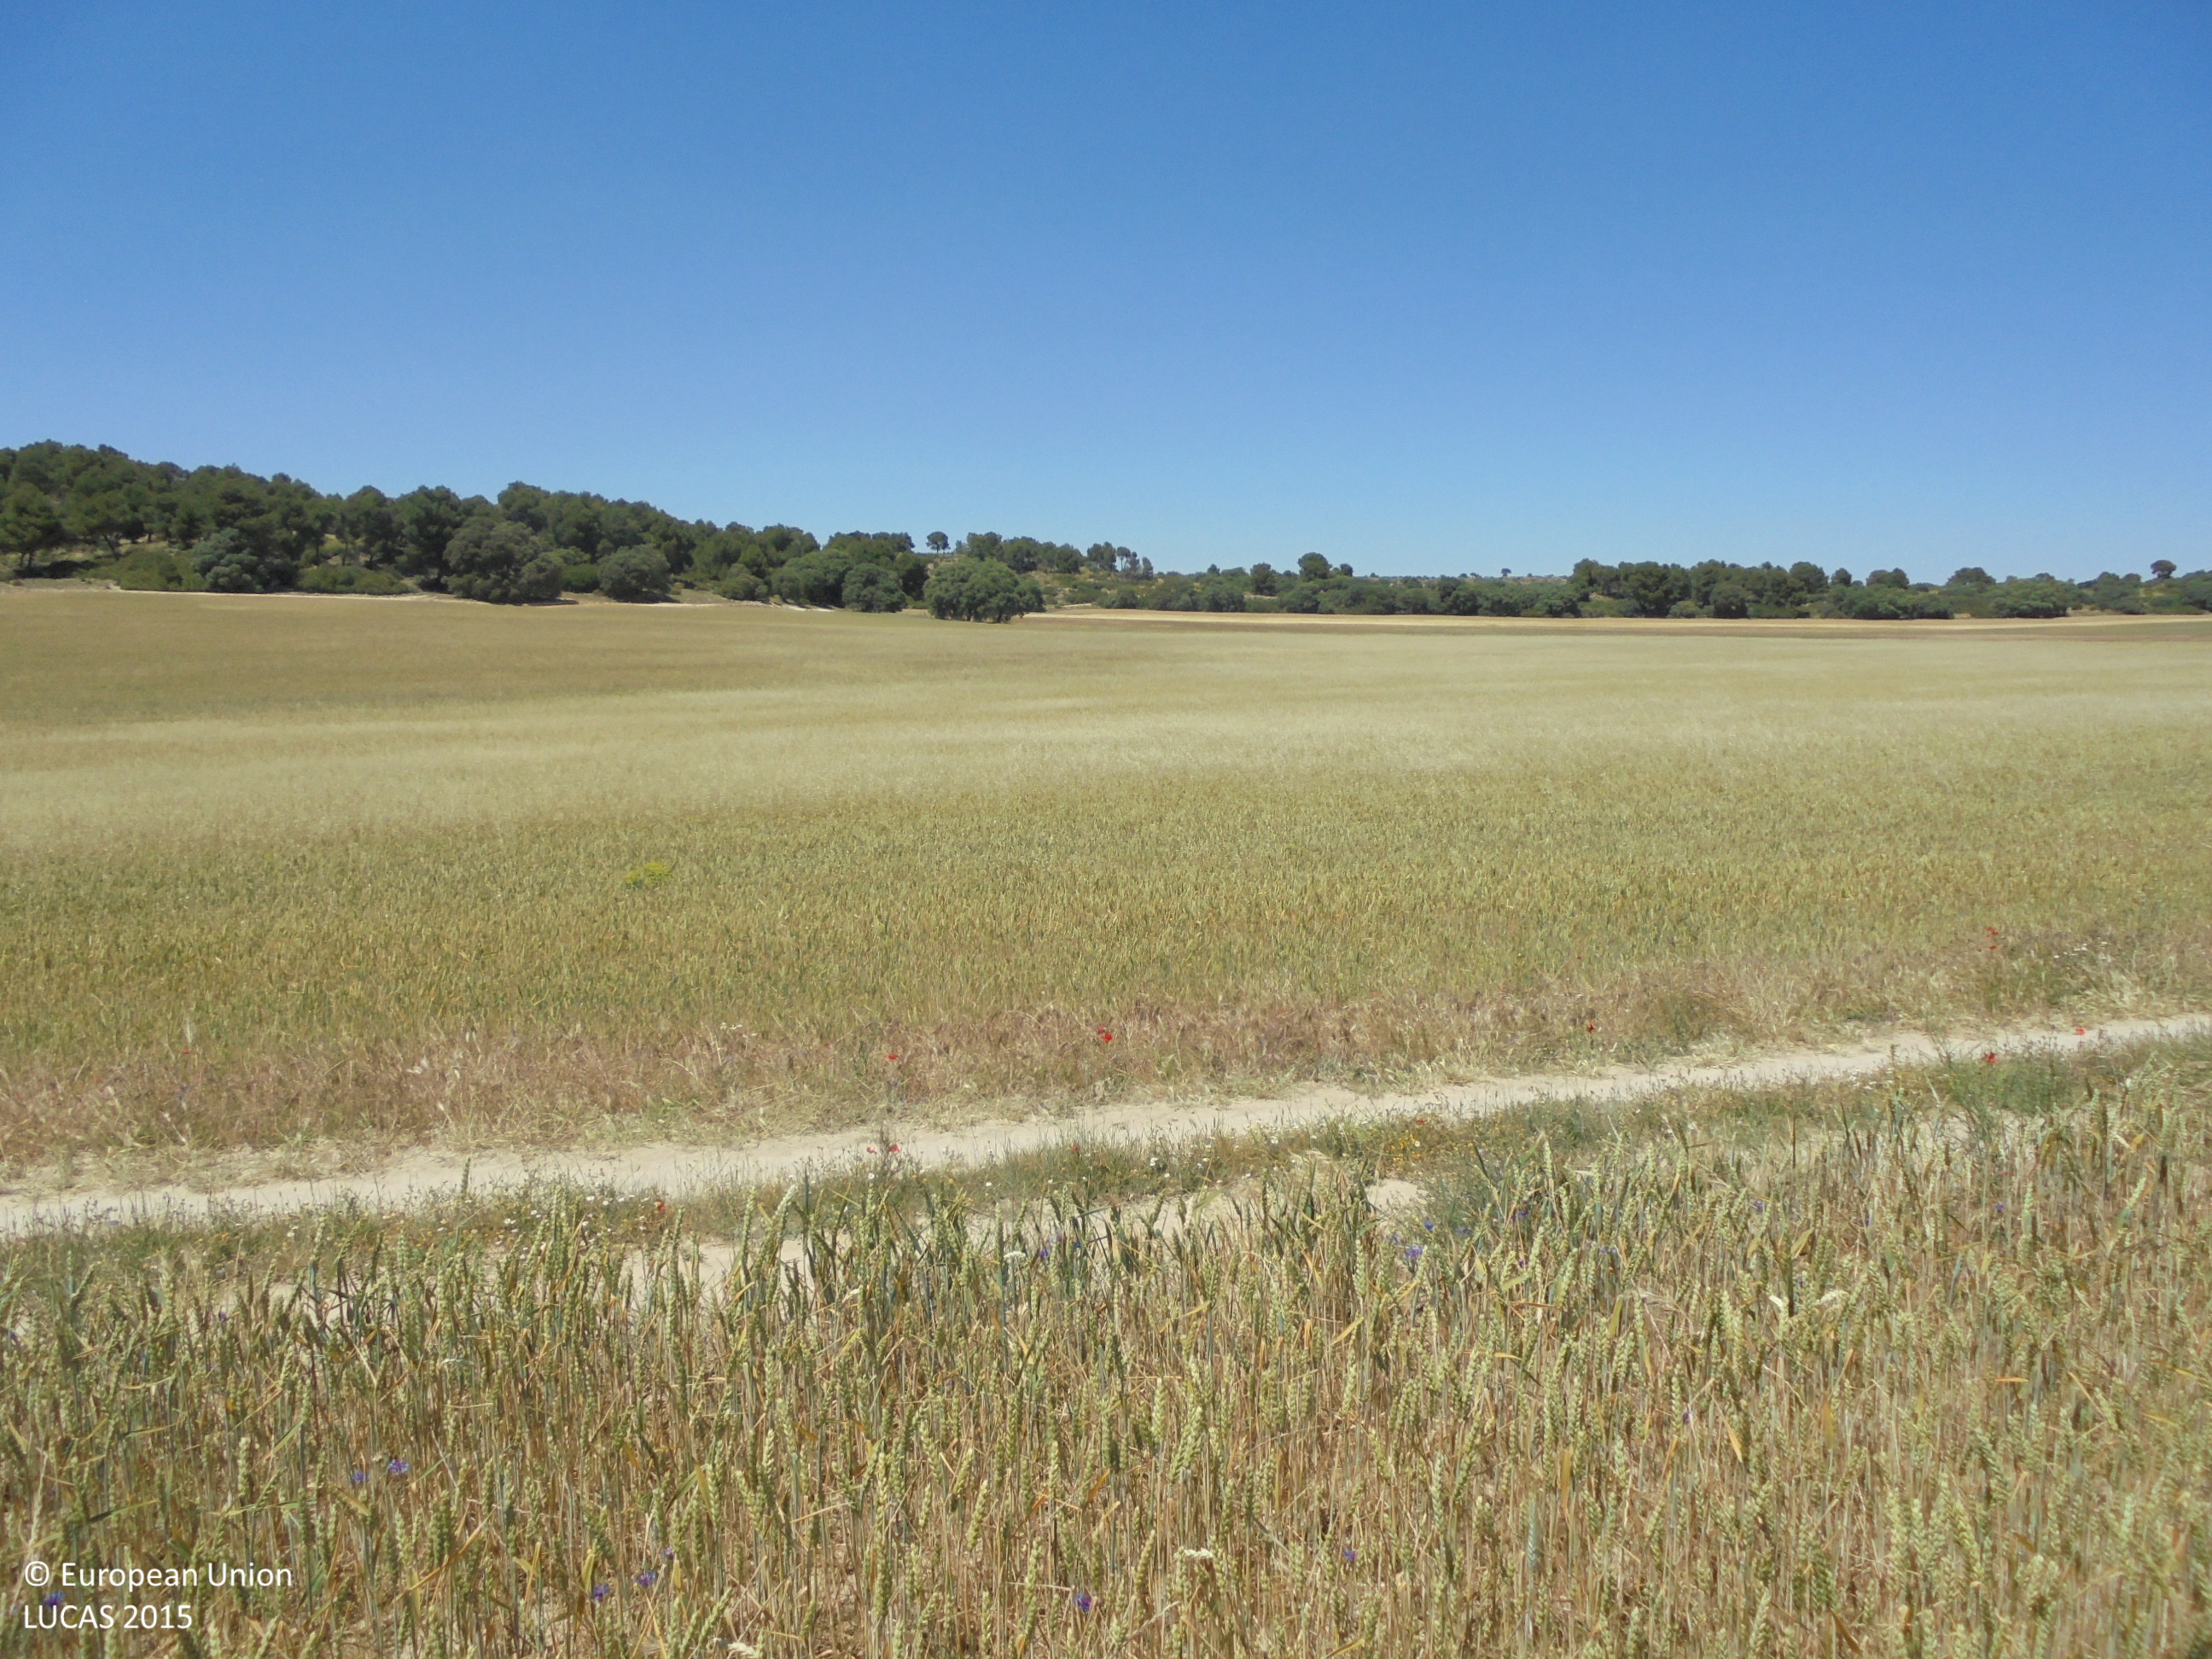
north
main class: Cropland
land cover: Durum wheat
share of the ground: 50 - 75 %
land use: Agriculture (excluding fallow land and kitchen gardens)
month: June
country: ES
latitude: 38.8048
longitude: -1.6384
